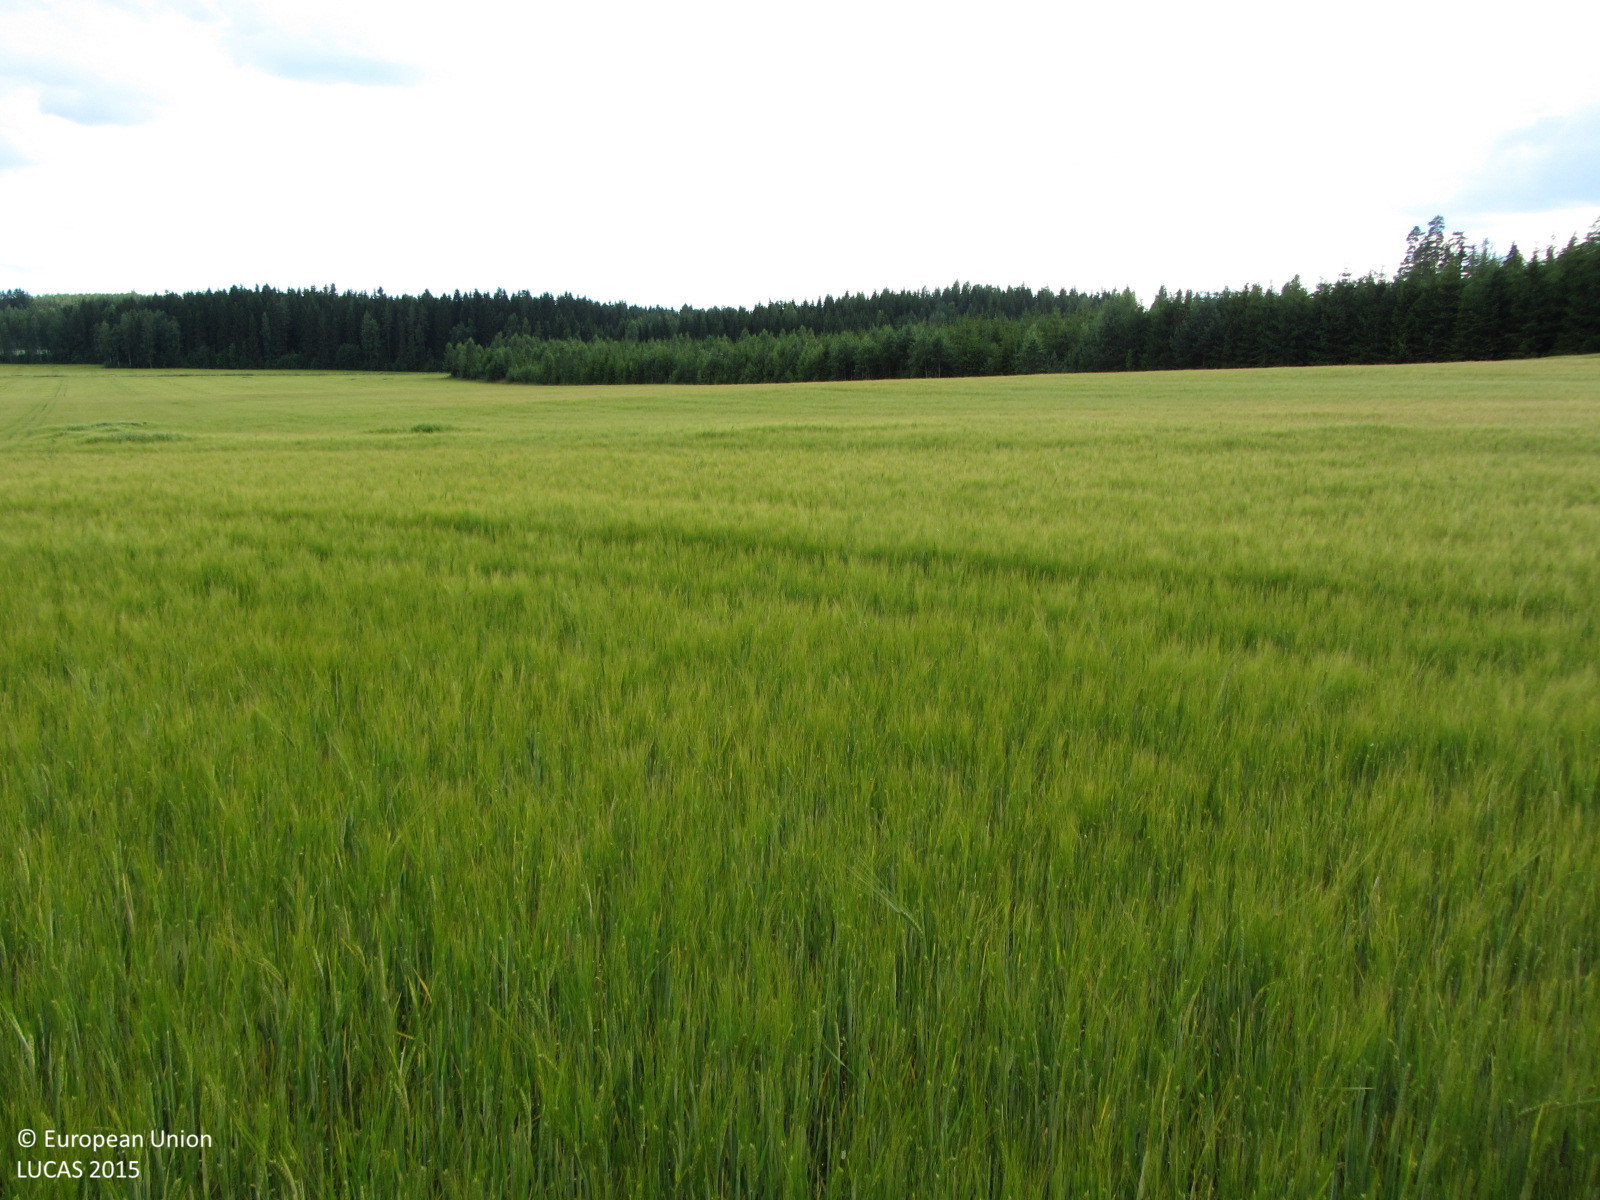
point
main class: Cropland
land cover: Barley
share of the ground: > 75 %
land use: Agriculture (excluding fallow land and kitchen gardens)
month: July
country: FI
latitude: 60.6729
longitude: 24.5097
